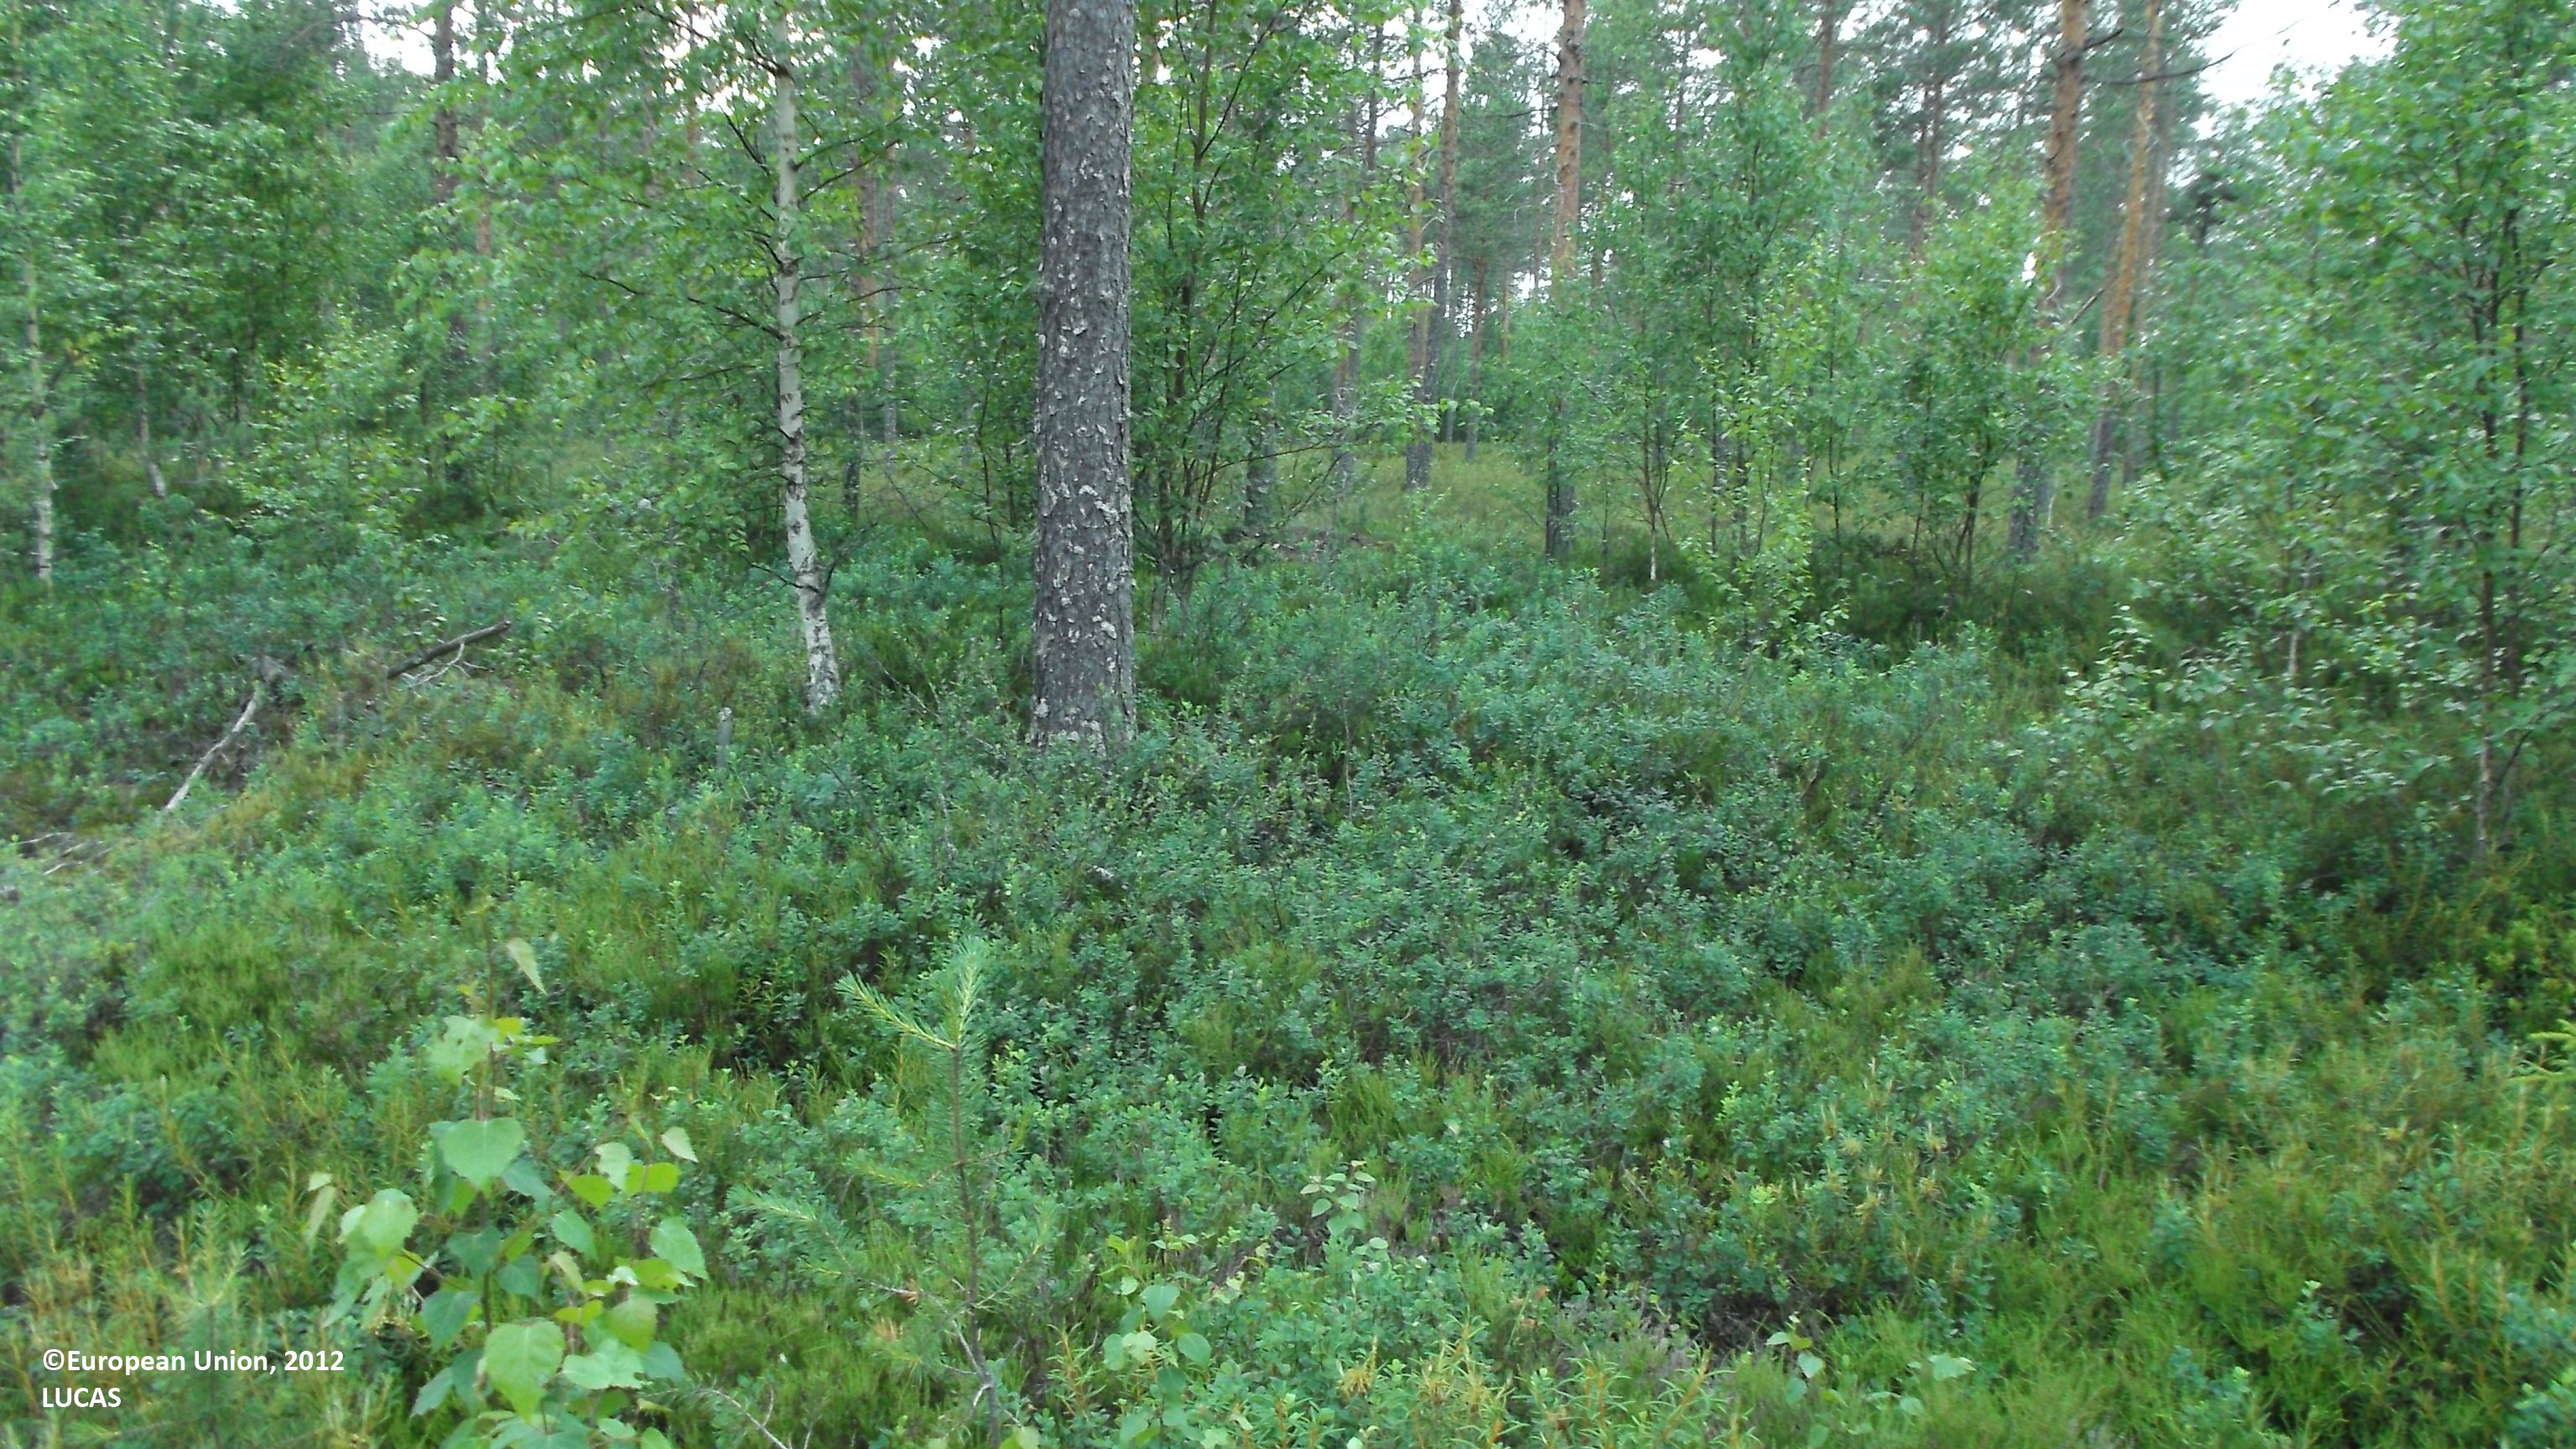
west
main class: Woodland
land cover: Pine dominated mixed woodland
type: boreal forest
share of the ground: 10 - 25 %
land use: Forestry
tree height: > 5 m
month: July
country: FI
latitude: 63.2658
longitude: 23.5137
